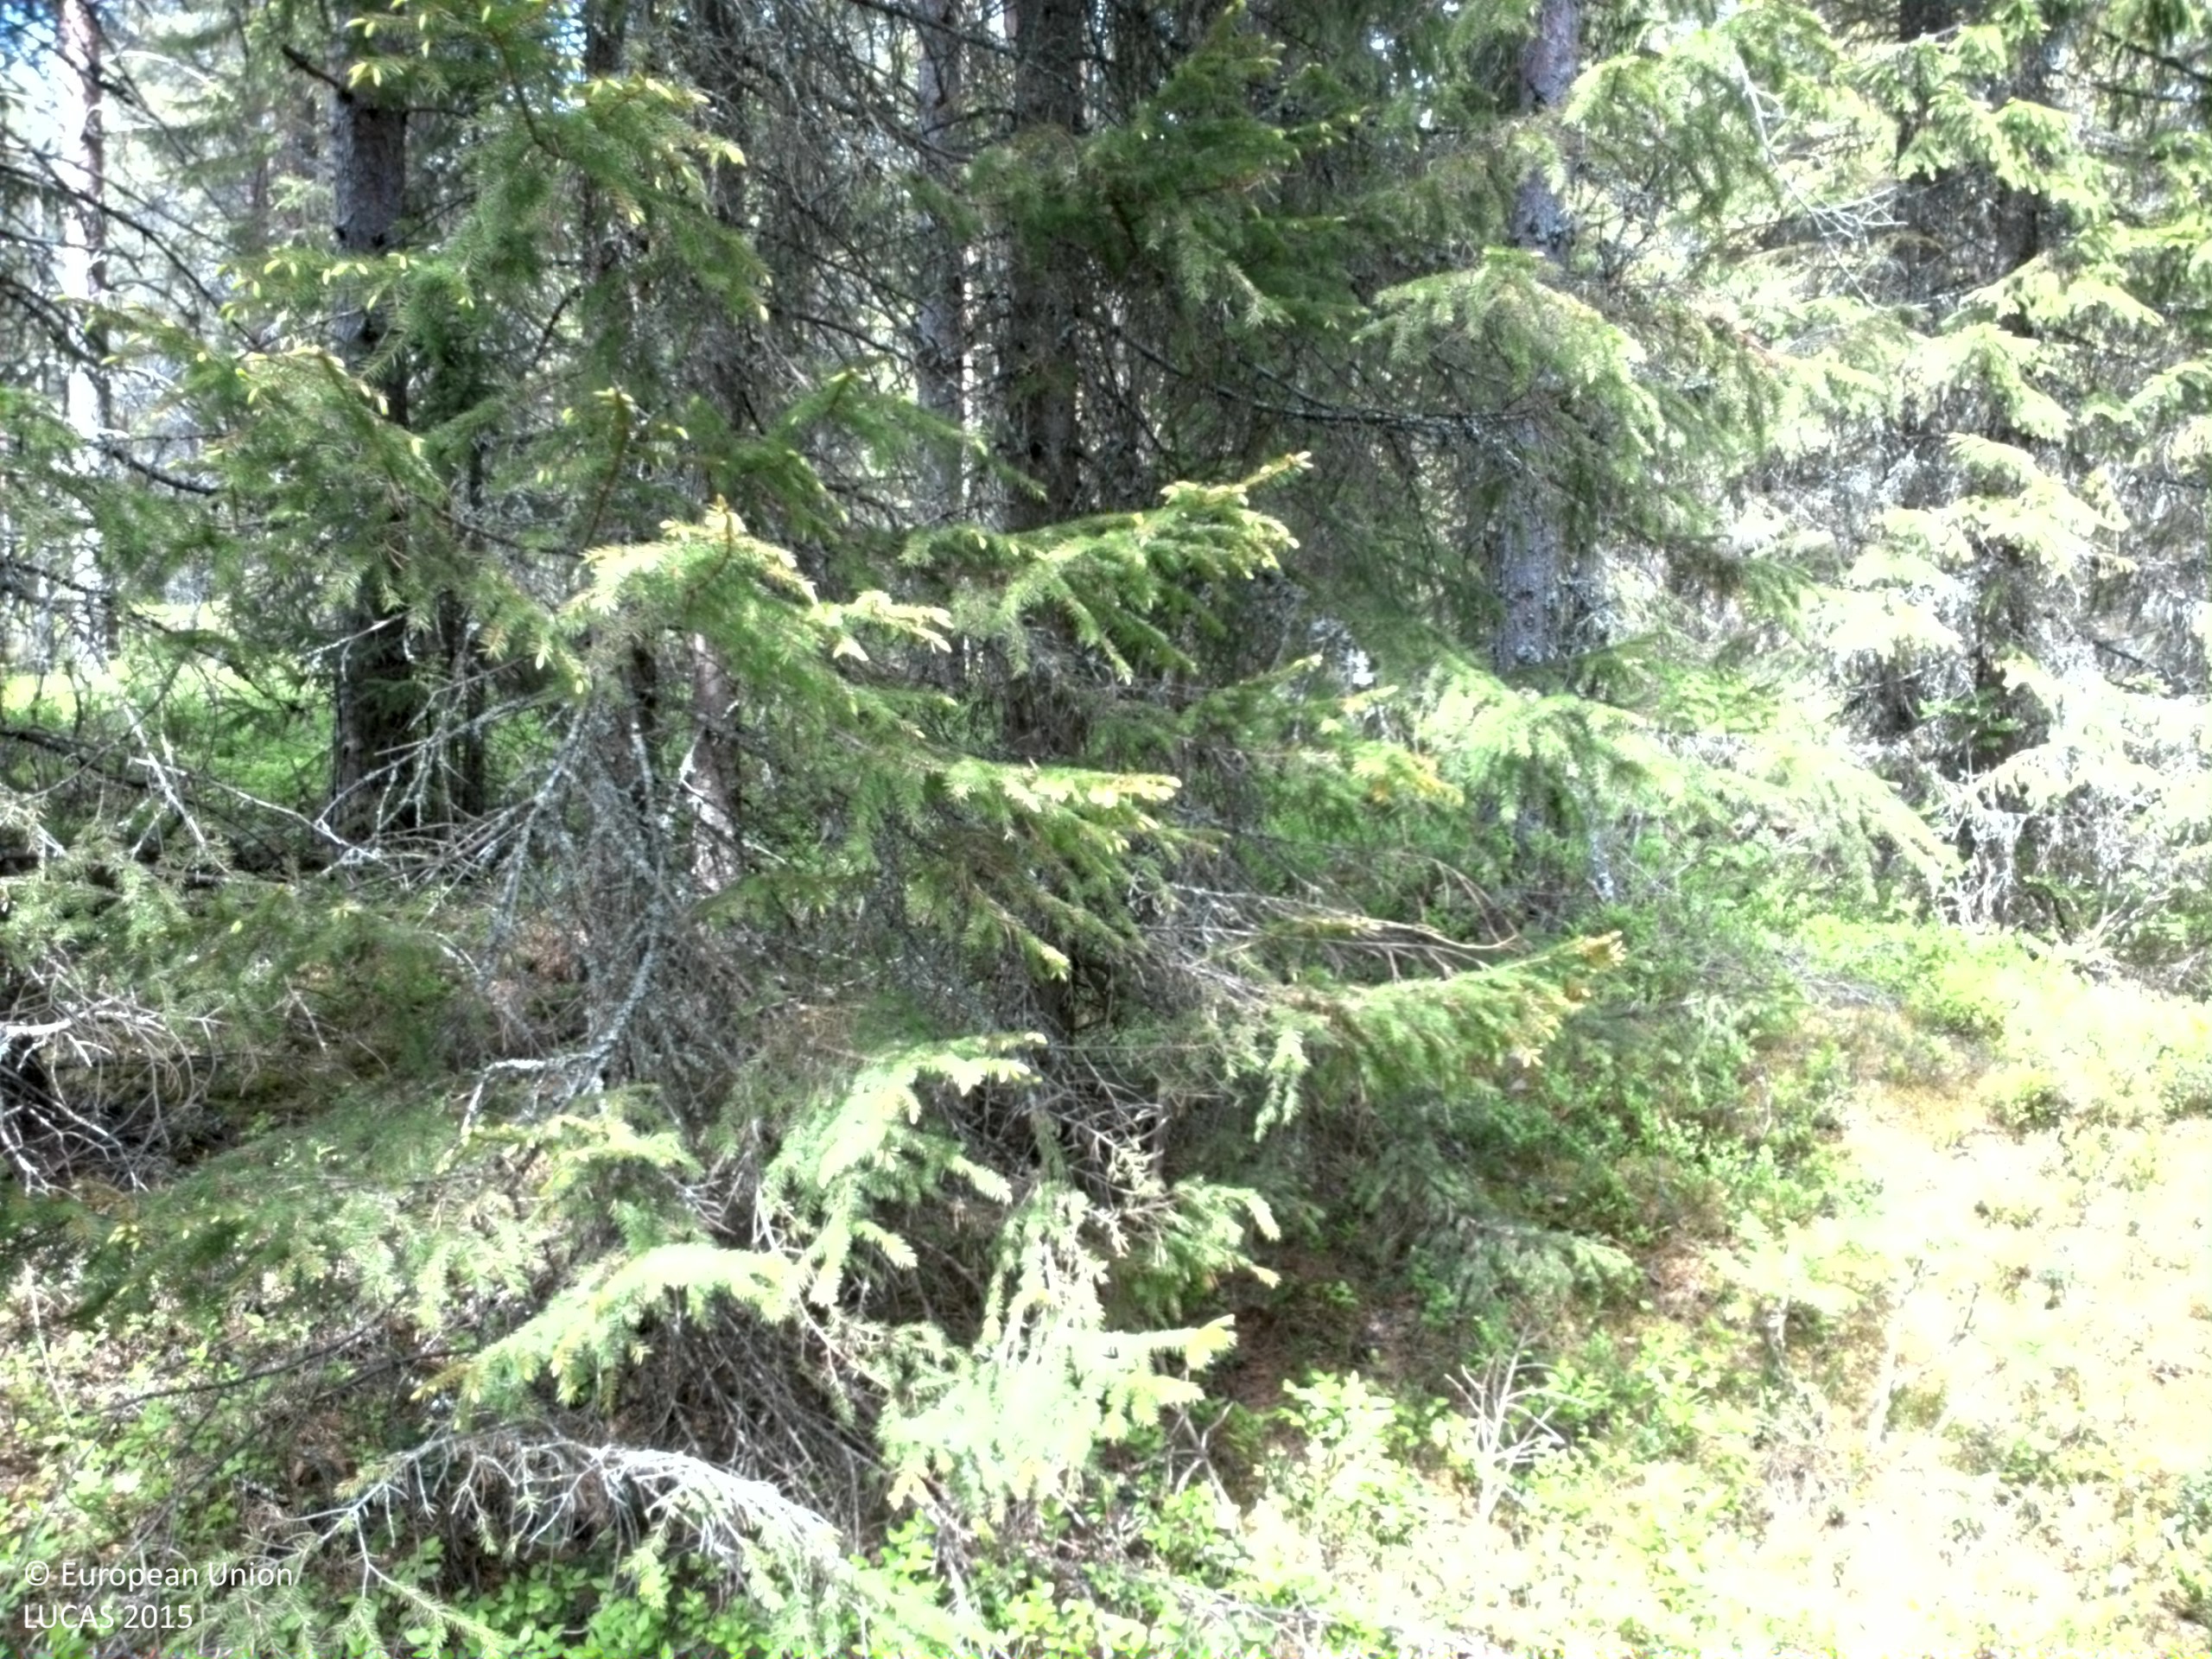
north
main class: Woodland
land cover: Spruce dominated mixed woodland
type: boreal forest
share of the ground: 50 - 75 %
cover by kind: coniferous forest trees 45 %, shrubs 40 %, broadleaved forest trees 15 %
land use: Forestry
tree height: > 5 m
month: June
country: SE
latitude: 63.2402
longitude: 17.8795
